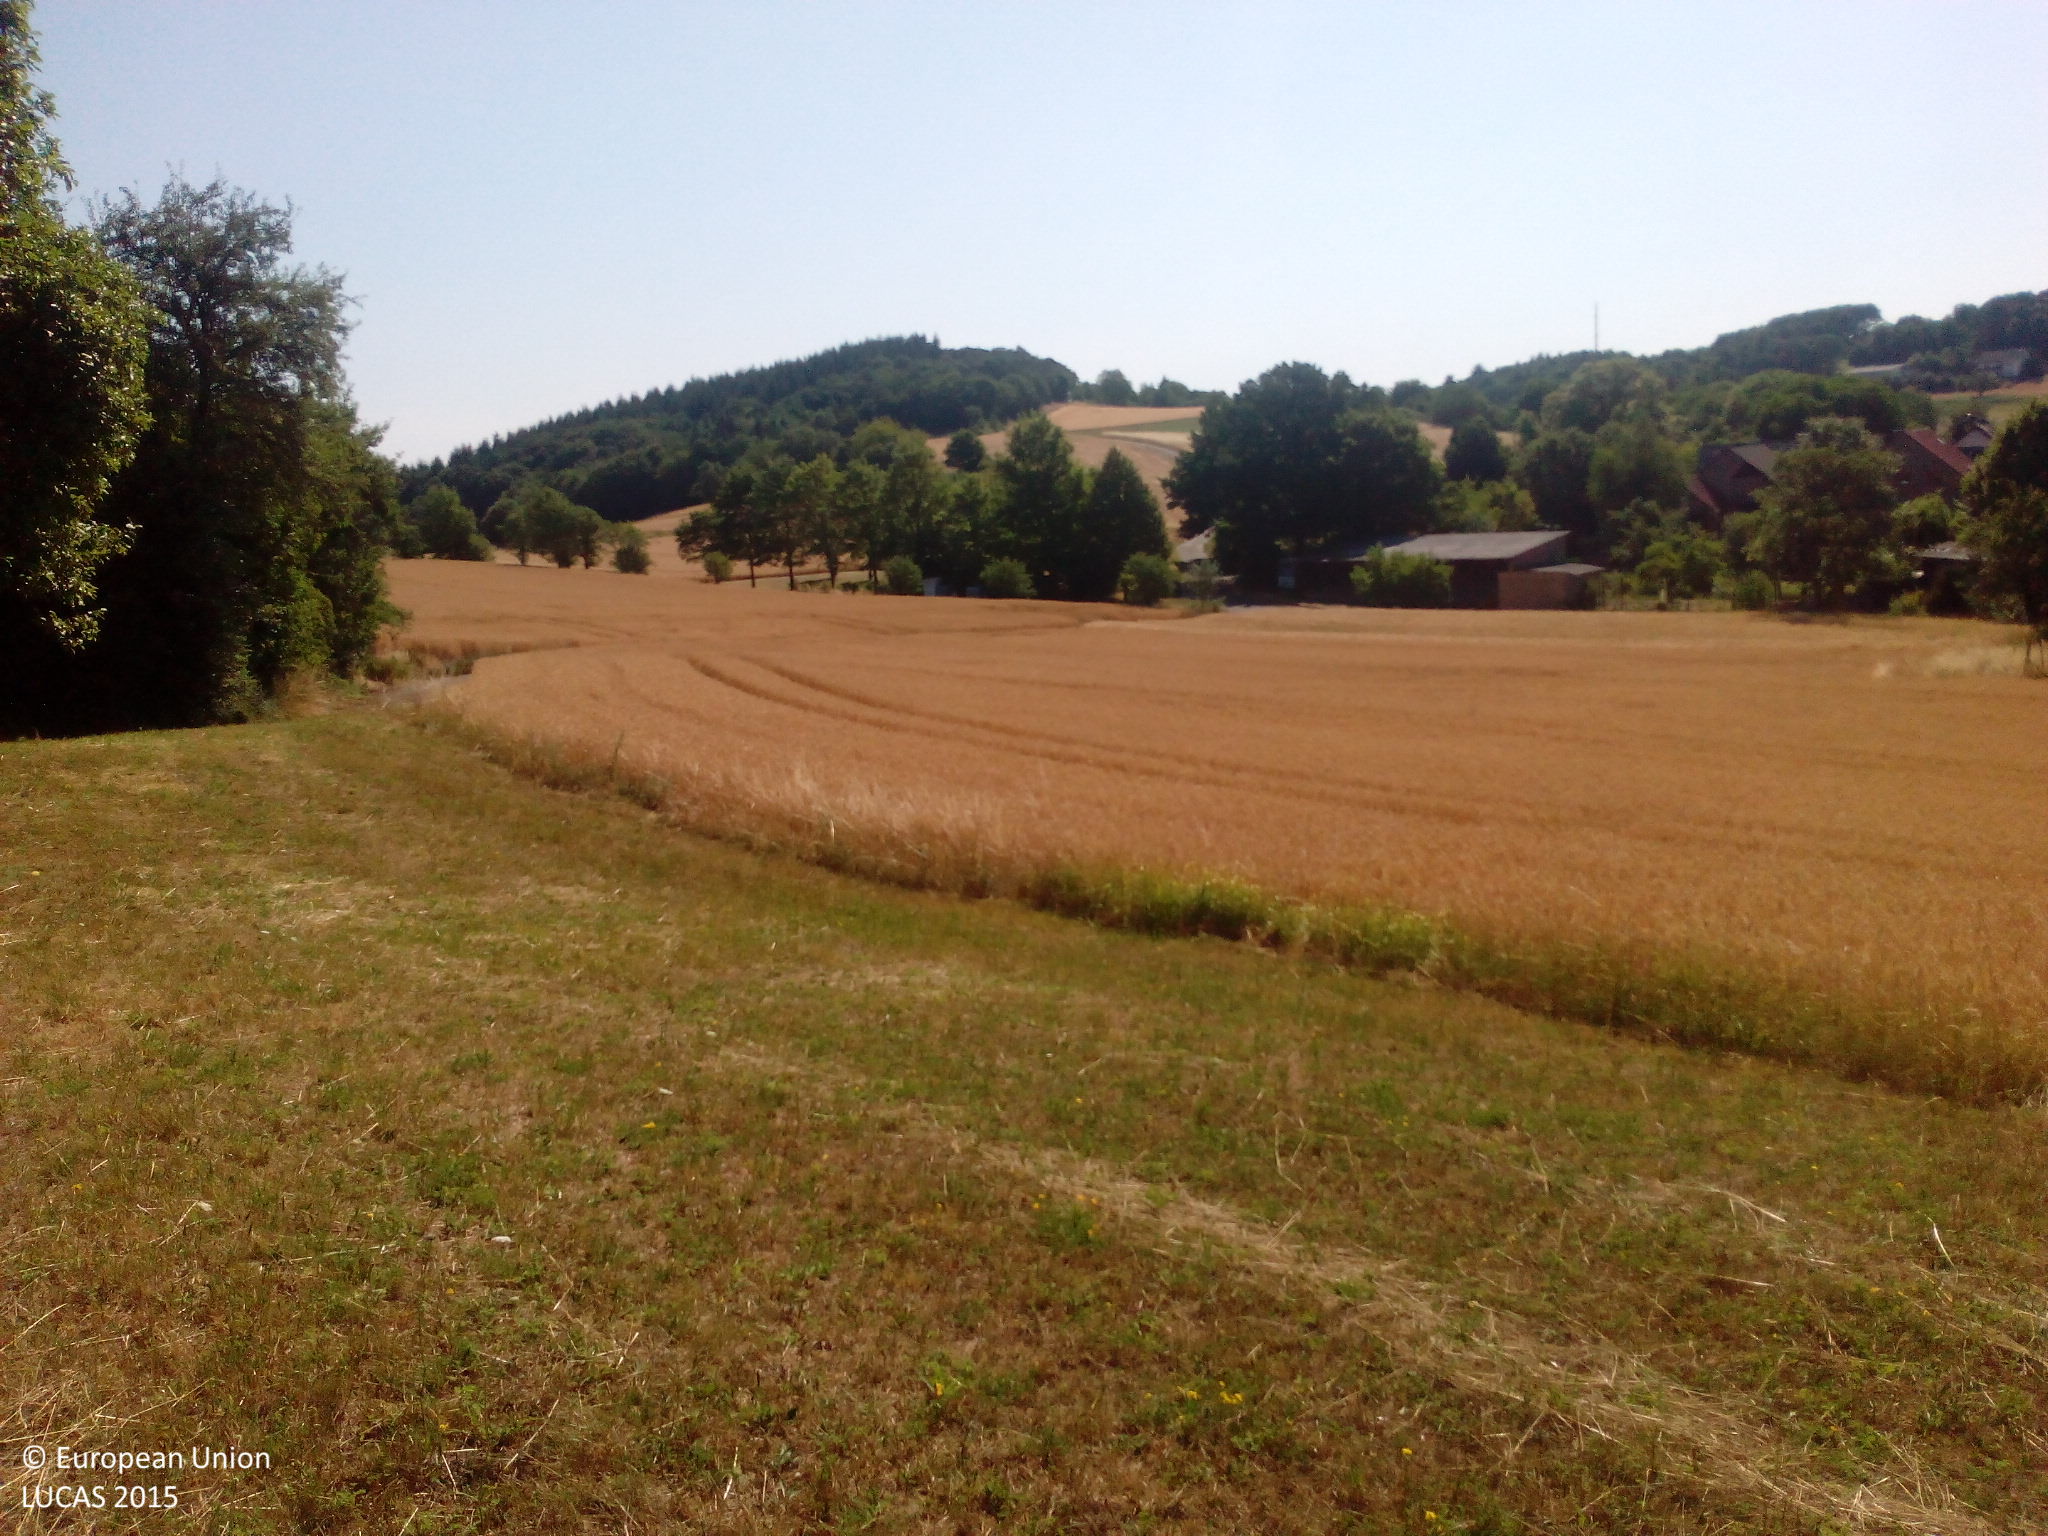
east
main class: Grassland
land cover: Grassland without tree/shrub cover
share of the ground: > 75 %
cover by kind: herbaceous plants 95 %, unconsolidated bare surface 5 %
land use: Agriculture (excluding fallow land and kitchen gardens)
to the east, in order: Grassland without tree/shrub cover; Common wheat; Paved roads, cycling and walking lanes; Common wheat; Lines of trees; Dry stone walls; Paved roads, cycling and walking lanes; Broadleaved woodland; Common wheat; Grassland with sparse tree/shrub cover
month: July
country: DE
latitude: 49.7452
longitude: 7.5996
